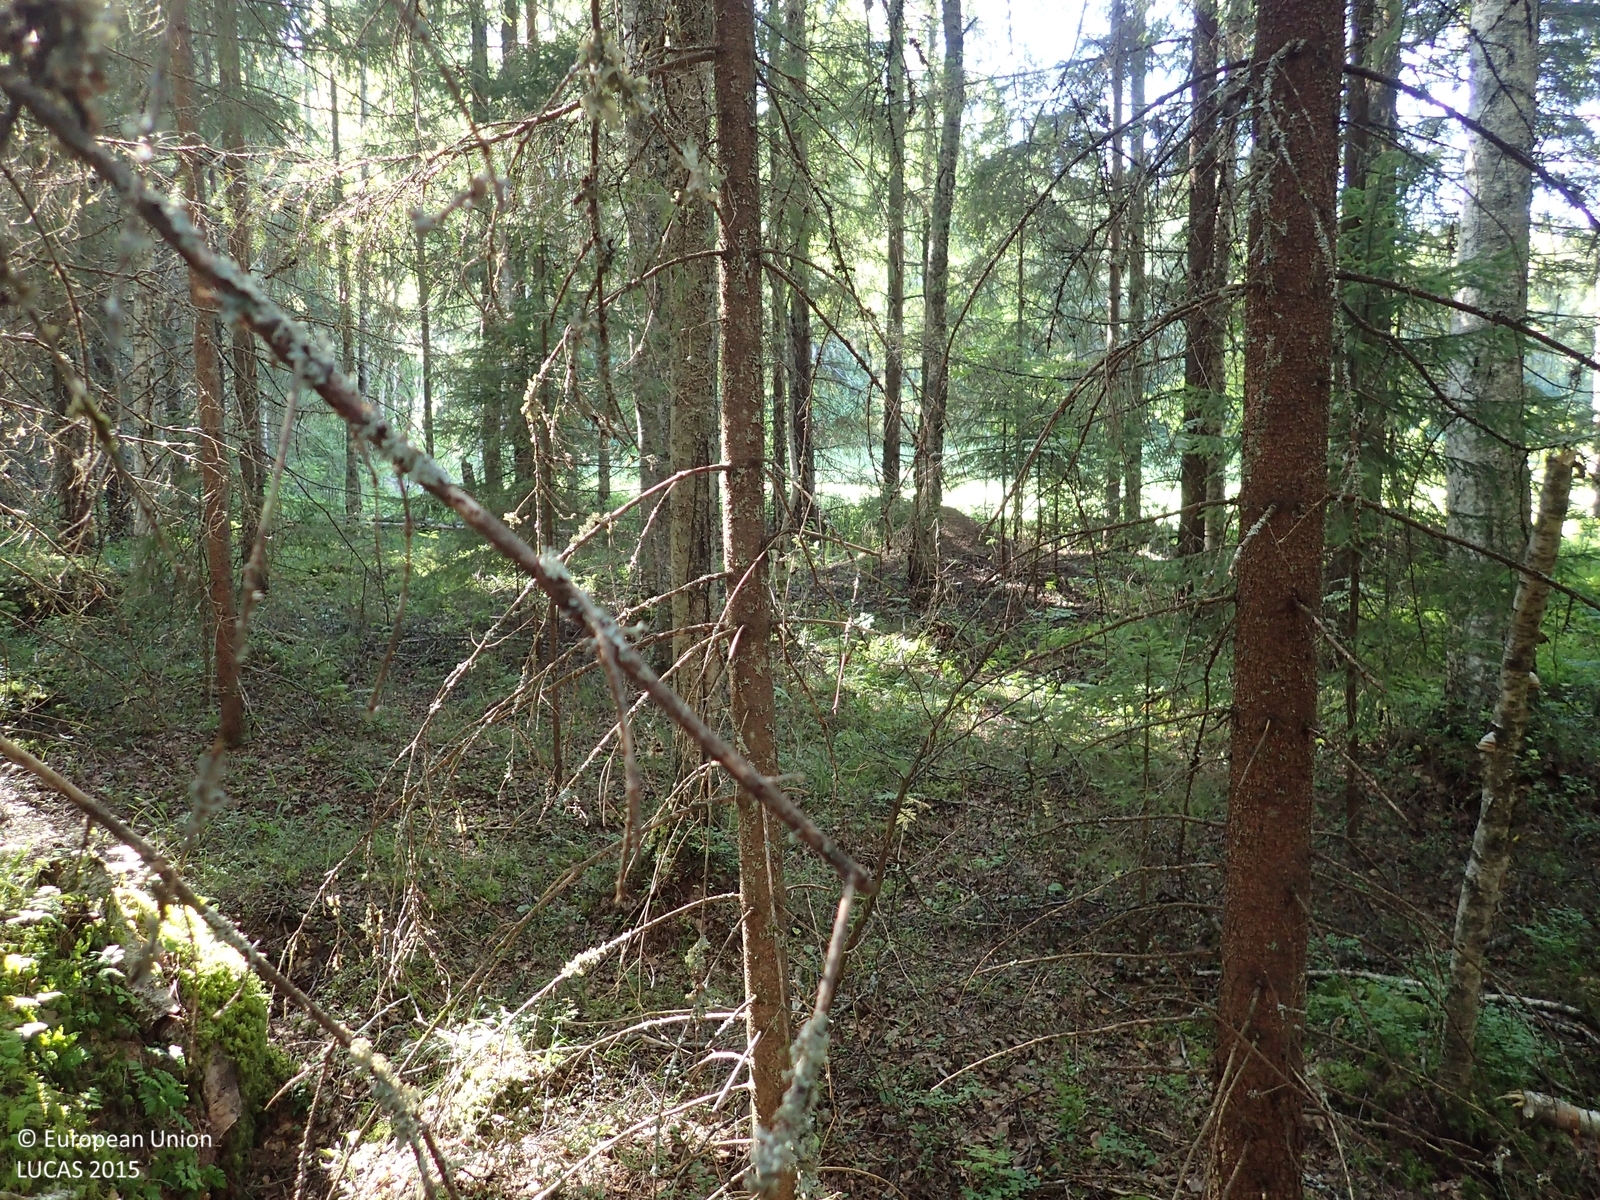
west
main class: Woodland
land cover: Spruce dominated coniferous woodland
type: boreal forest
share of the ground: > 75 %
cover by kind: coniferous forest trees 70 %, broadleaved forest trees 15 %, herbaceous plants 10 %, lichens and mosses 5 %
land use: Forestry
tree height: > 5 m
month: August
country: FI
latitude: 62.7452
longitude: 22.0859
